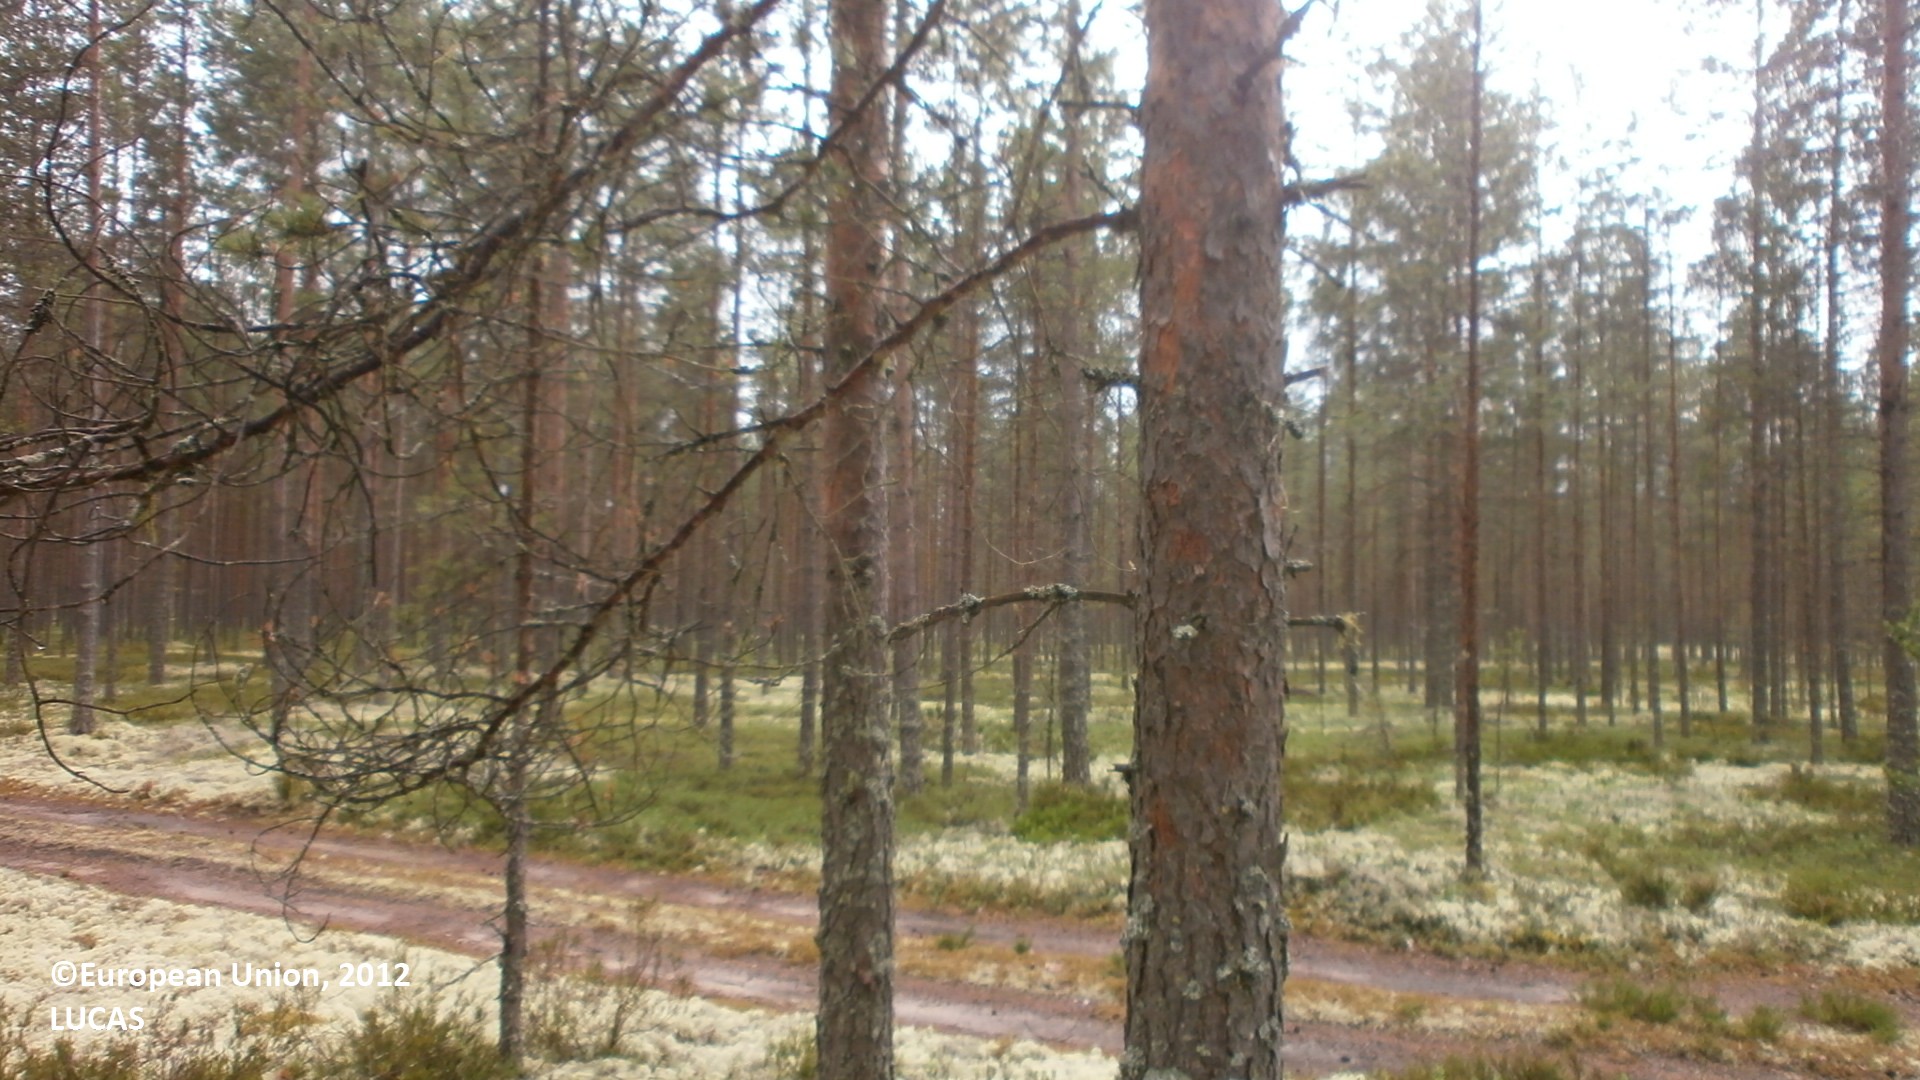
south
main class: Woodland
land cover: Pine dominated coniferous woodland
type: boreal forest
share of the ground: 50 - 75 %
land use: Forestry
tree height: > 5 m
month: July
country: FI
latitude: 64.1368
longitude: 23.8479
